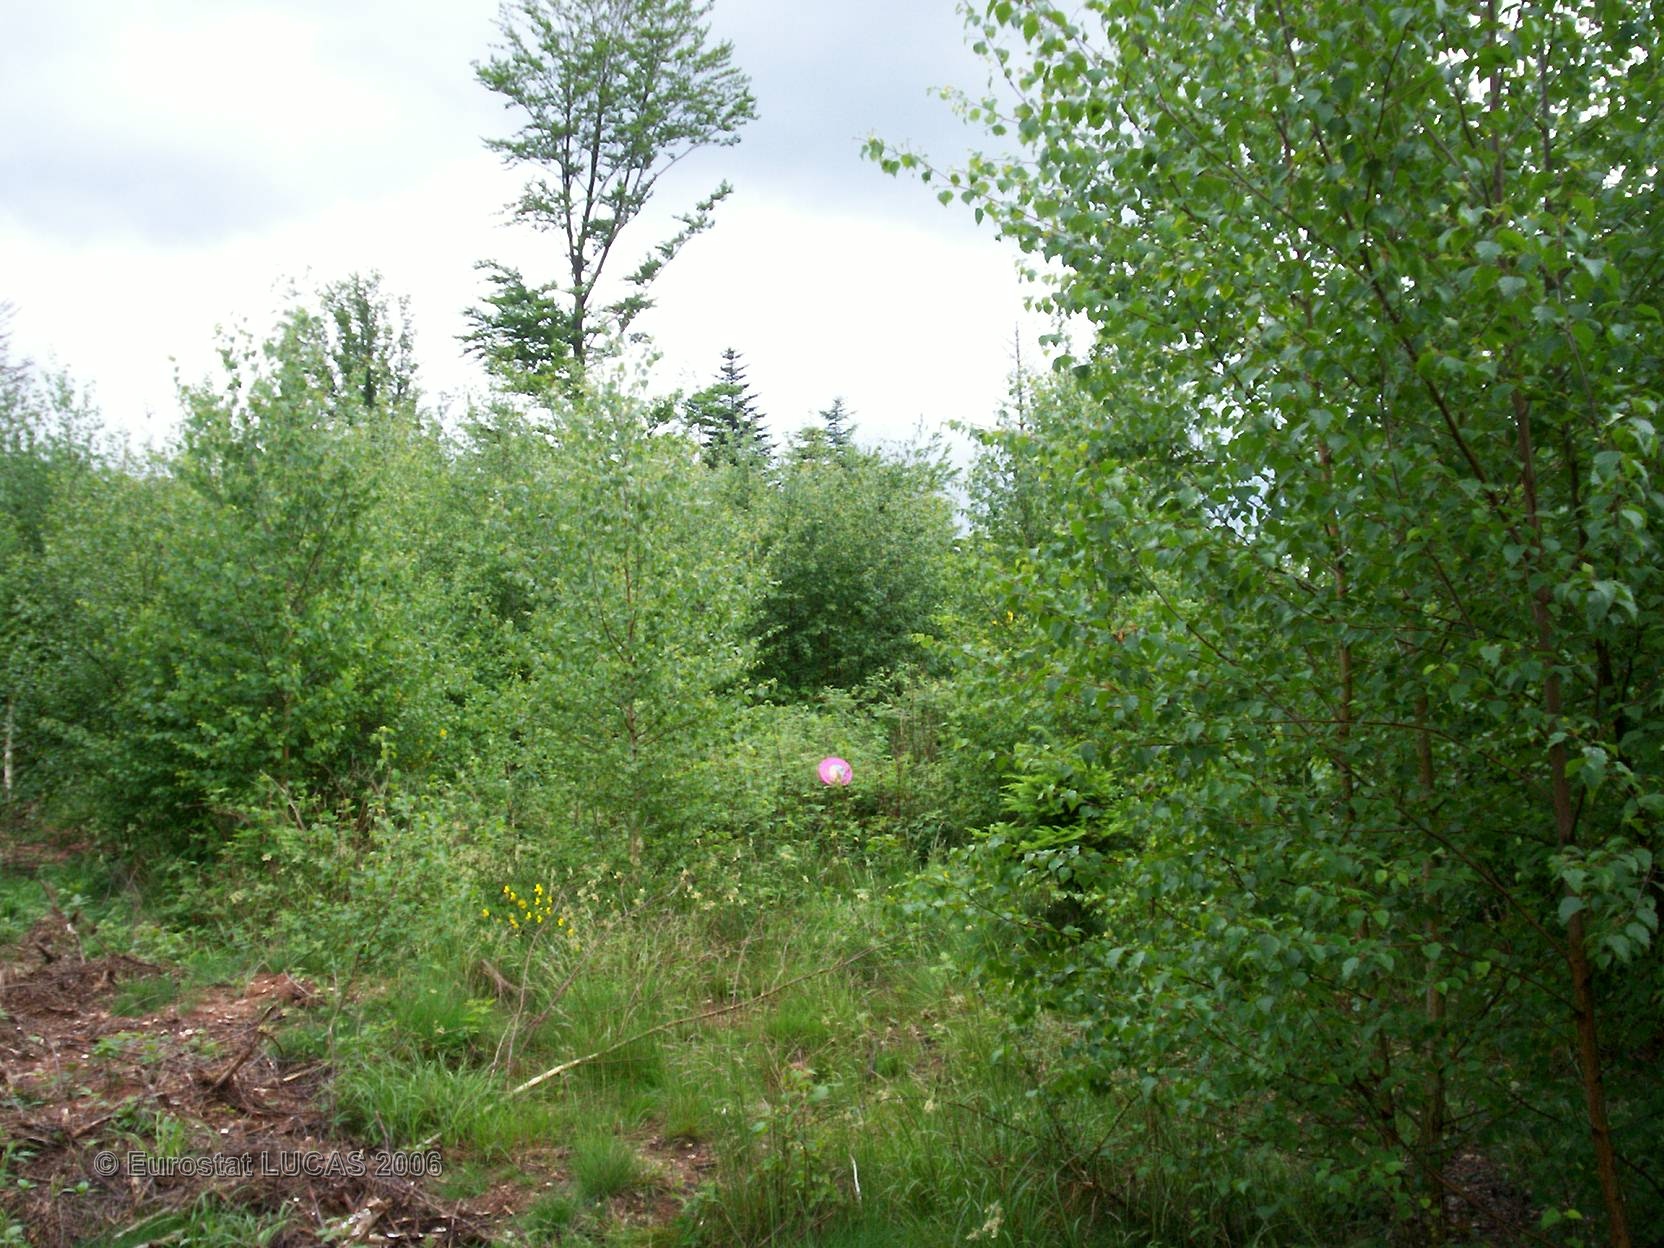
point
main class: Woodland
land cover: Broadleaved forest
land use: Forestry
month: May
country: FR
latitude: 48.5236
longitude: 6.9542
